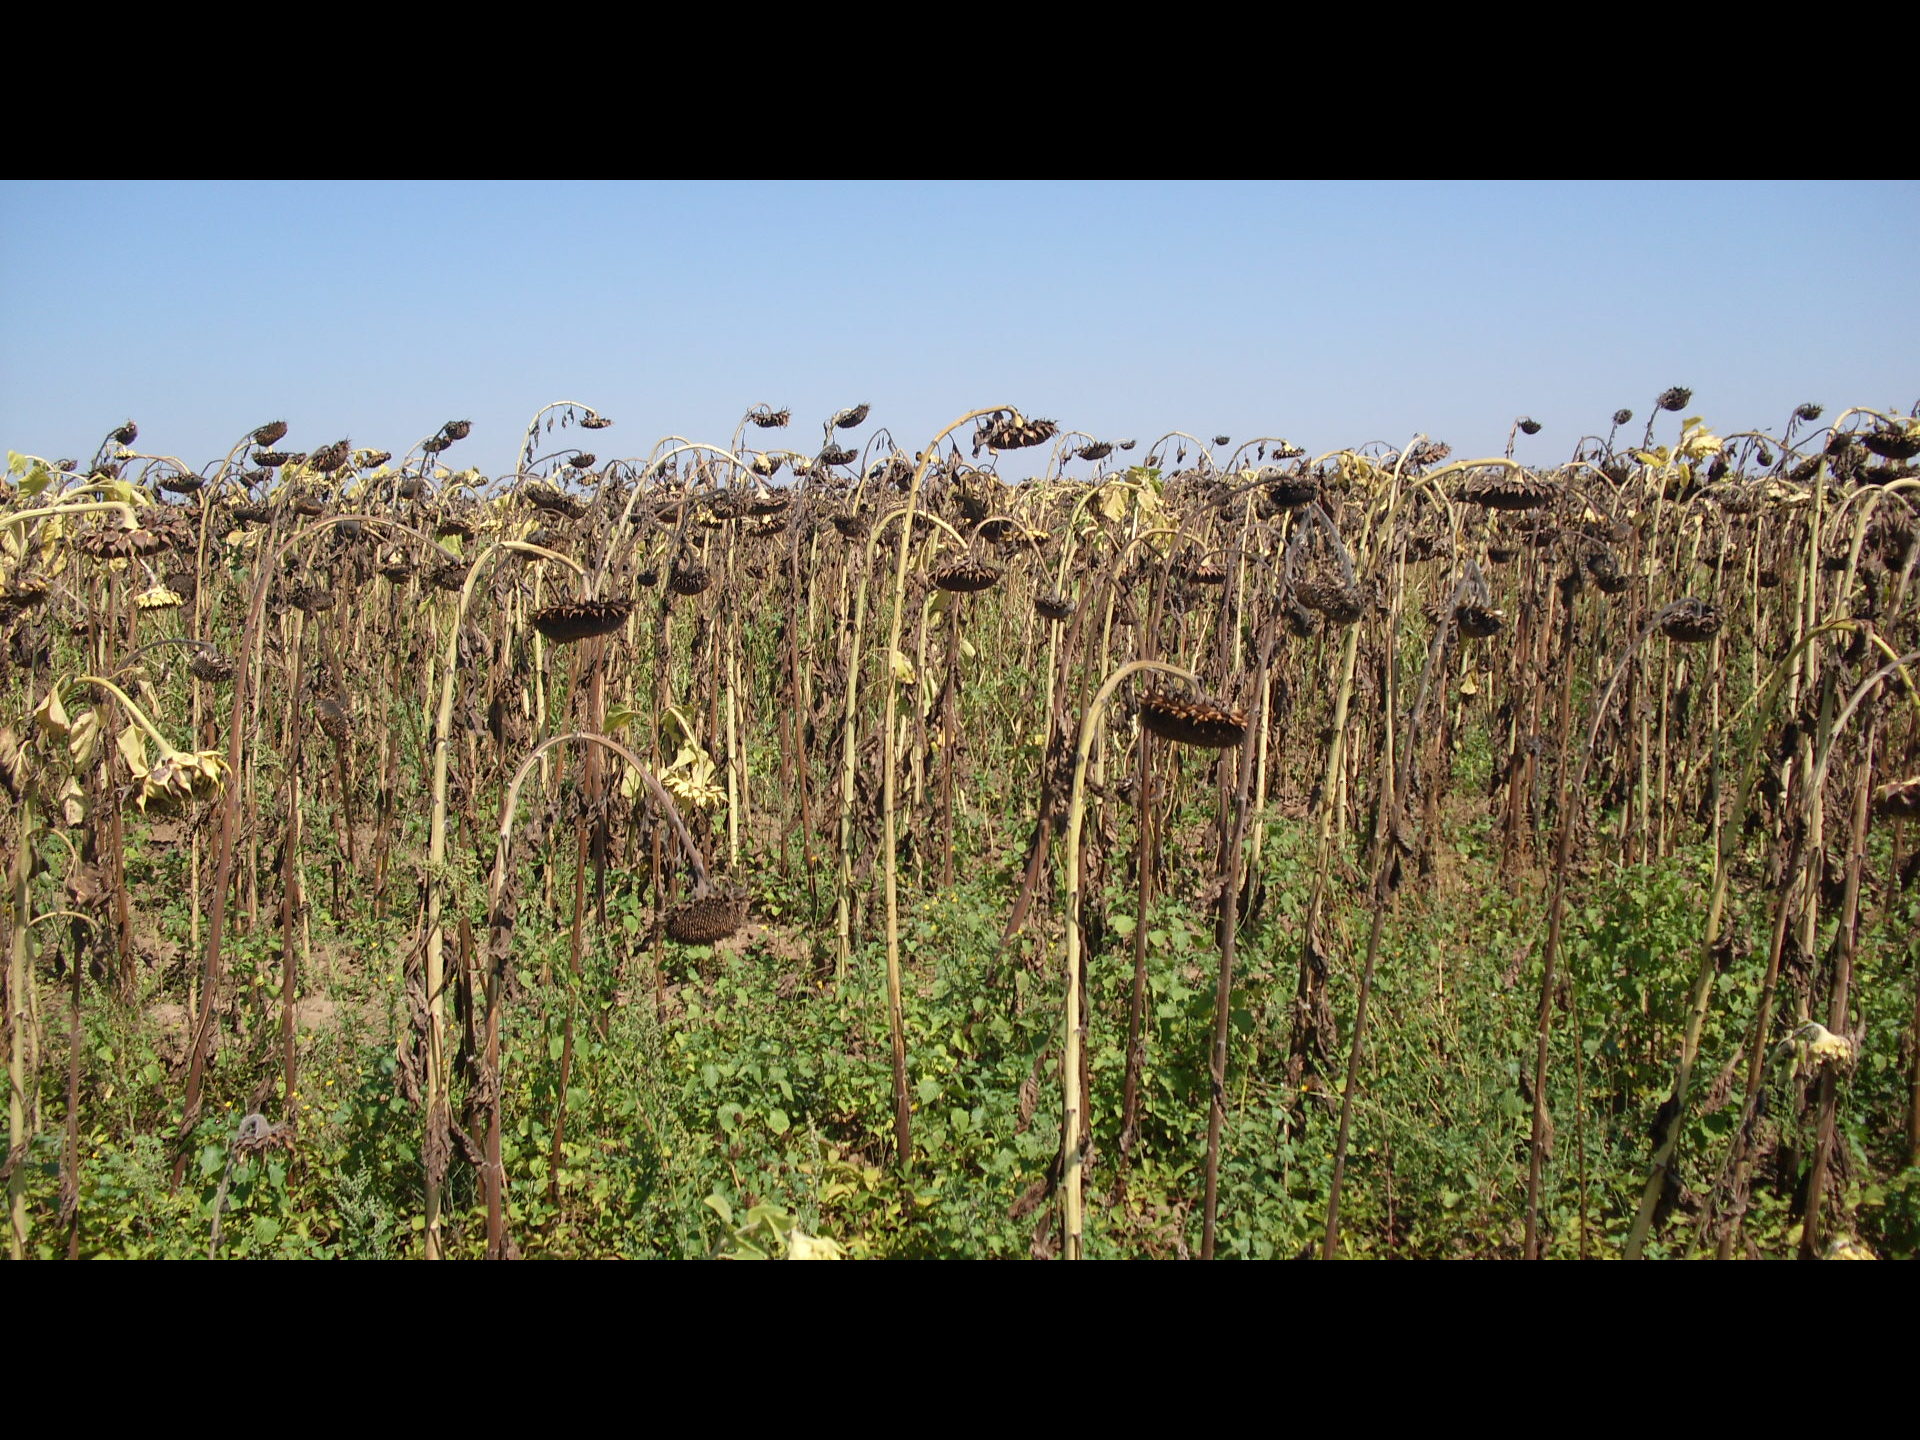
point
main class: Cropland
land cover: Sunflower
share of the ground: > 75 %
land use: Agriculture (excluding fallow land and kitchen gardens)
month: August
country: BG
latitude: 44.1855
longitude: 22.7114
